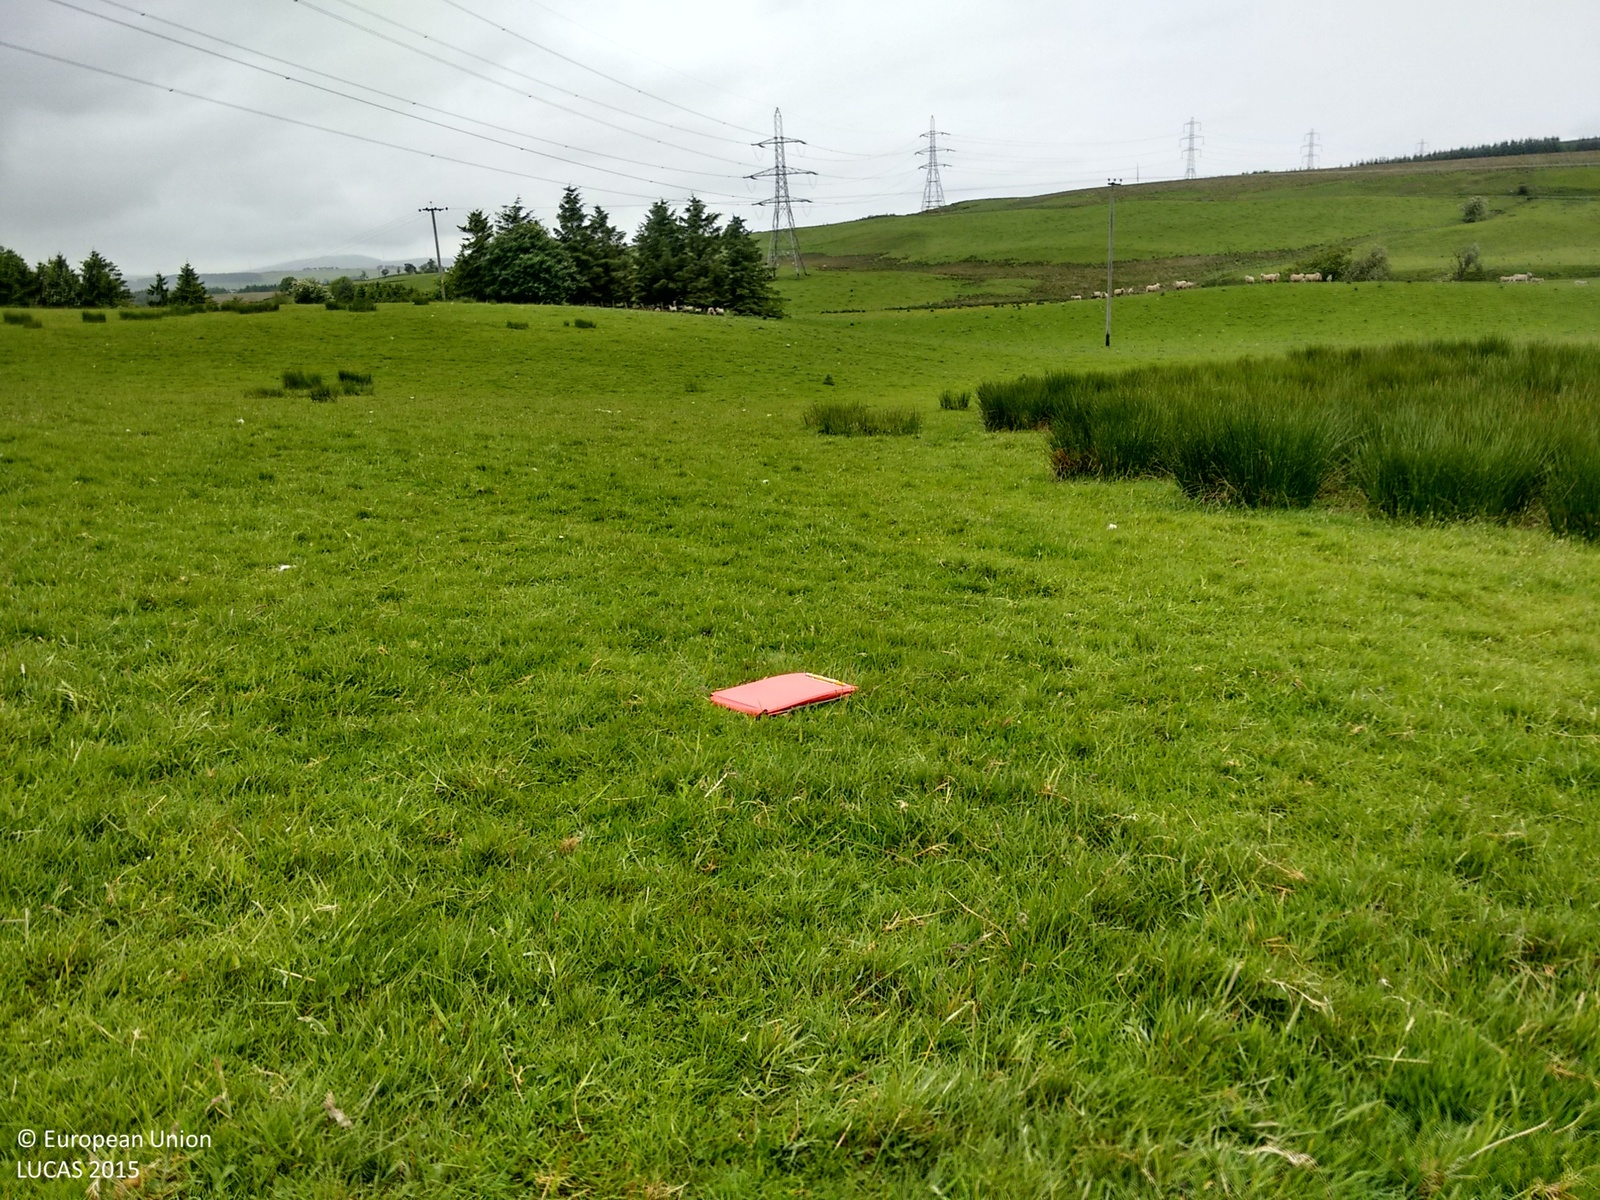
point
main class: Grassland
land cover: Grassland without tree/shrub cover
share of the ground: 50 - 75 %
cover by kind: herbaceous plants 100 %
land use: Agriculture (excluding fallow land and kitchen gardens)
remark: Clear cut
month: June
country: GB
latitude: 55.6002
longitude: -3.8134
